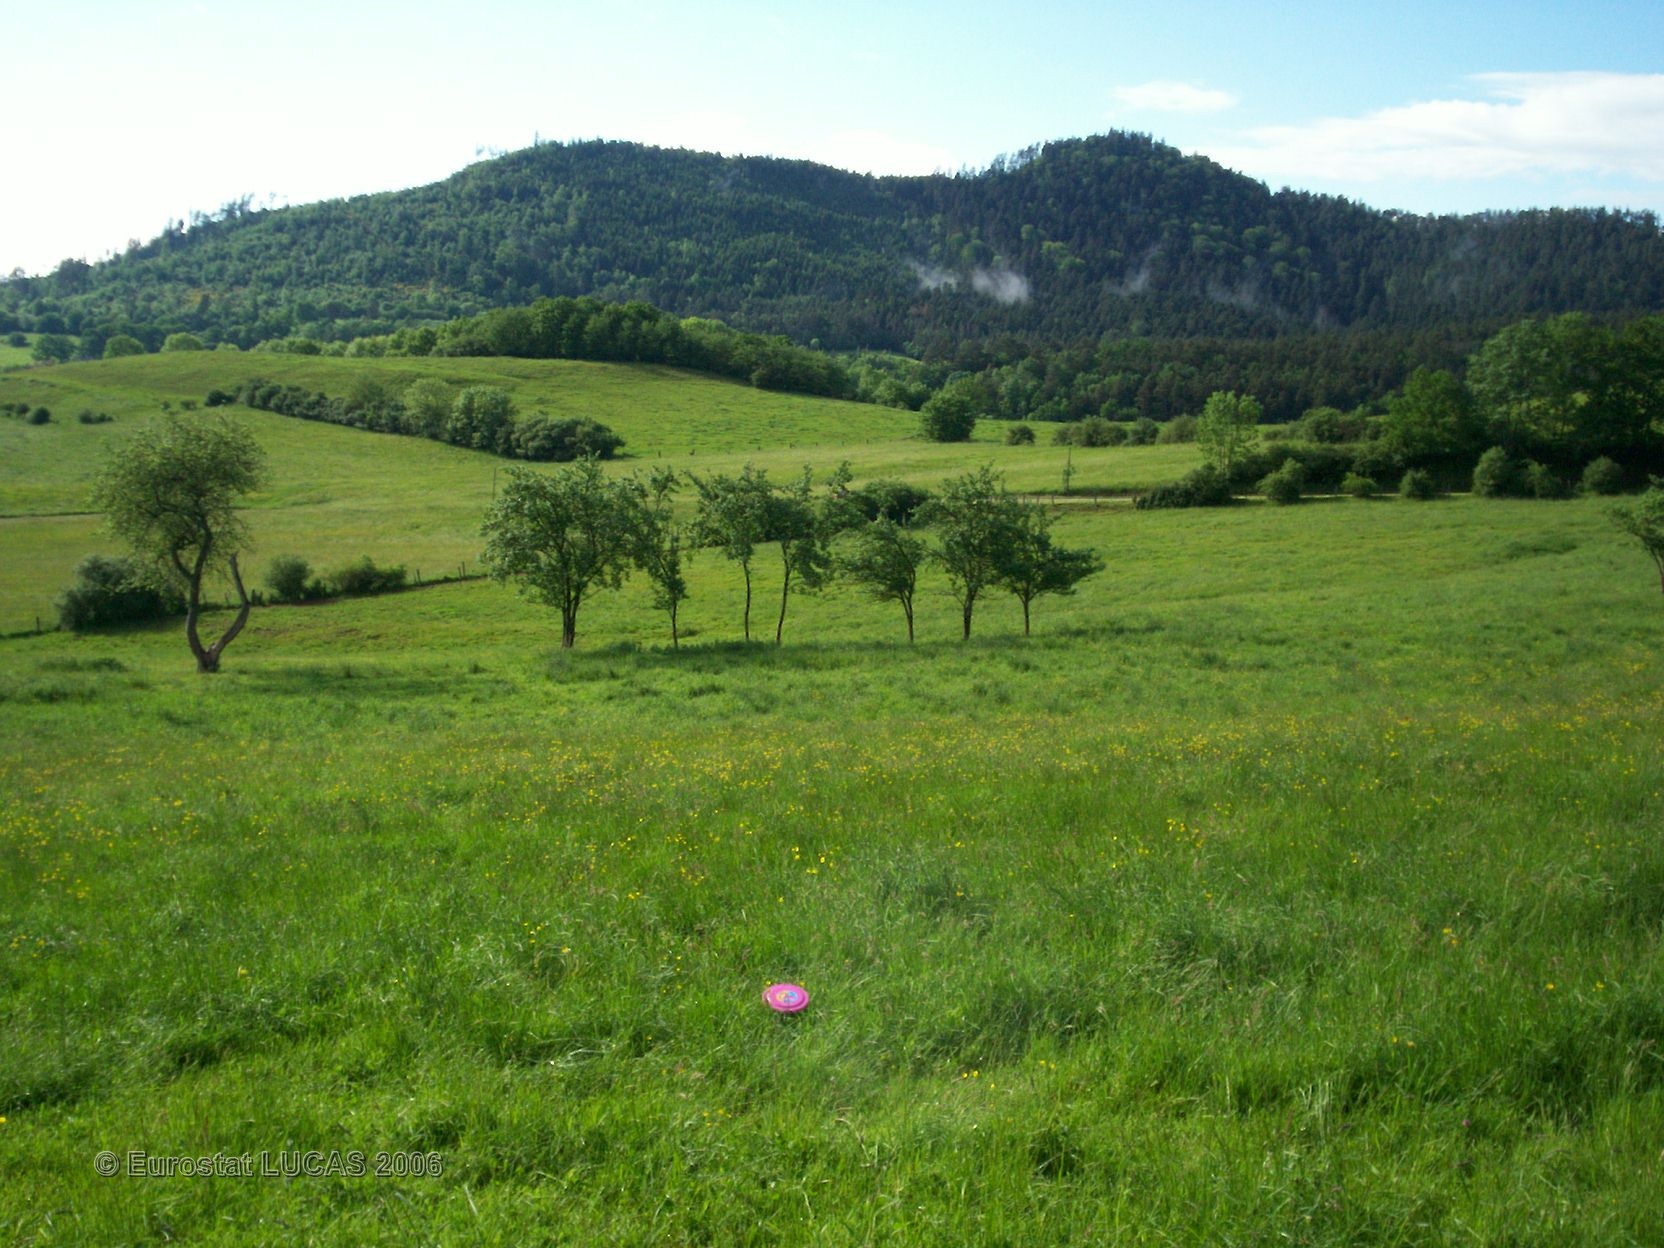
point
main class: Grassland
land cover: Grassland without tree/shrub cover
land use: Agriculture (excluding fallow land and kitchen gardens)
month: May
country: FR
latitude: 48.3079
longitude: 6.9672
